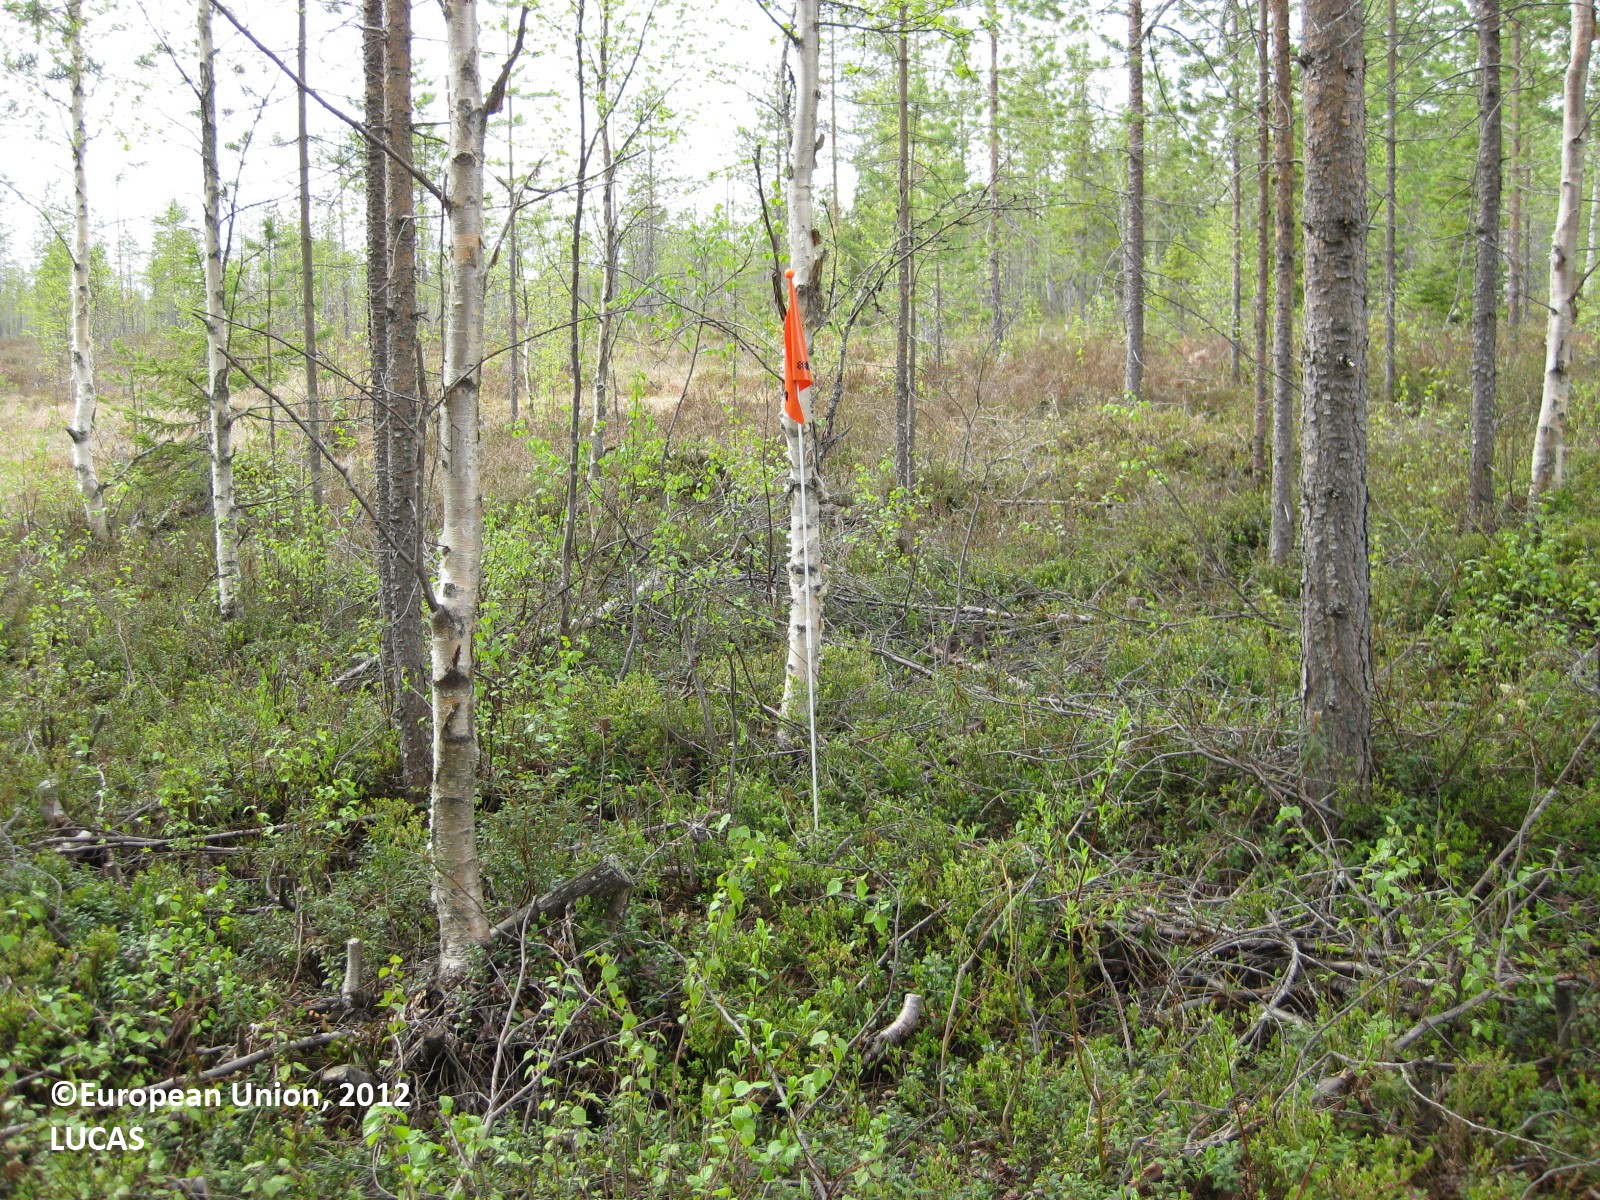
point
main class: Woodland
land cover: Pine dominated mixed woodland
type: boreal forest
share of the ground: > 75 %
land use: Forestry
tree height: > 5 m
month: June
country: FI
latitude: 65.3943
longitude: 29.2389
